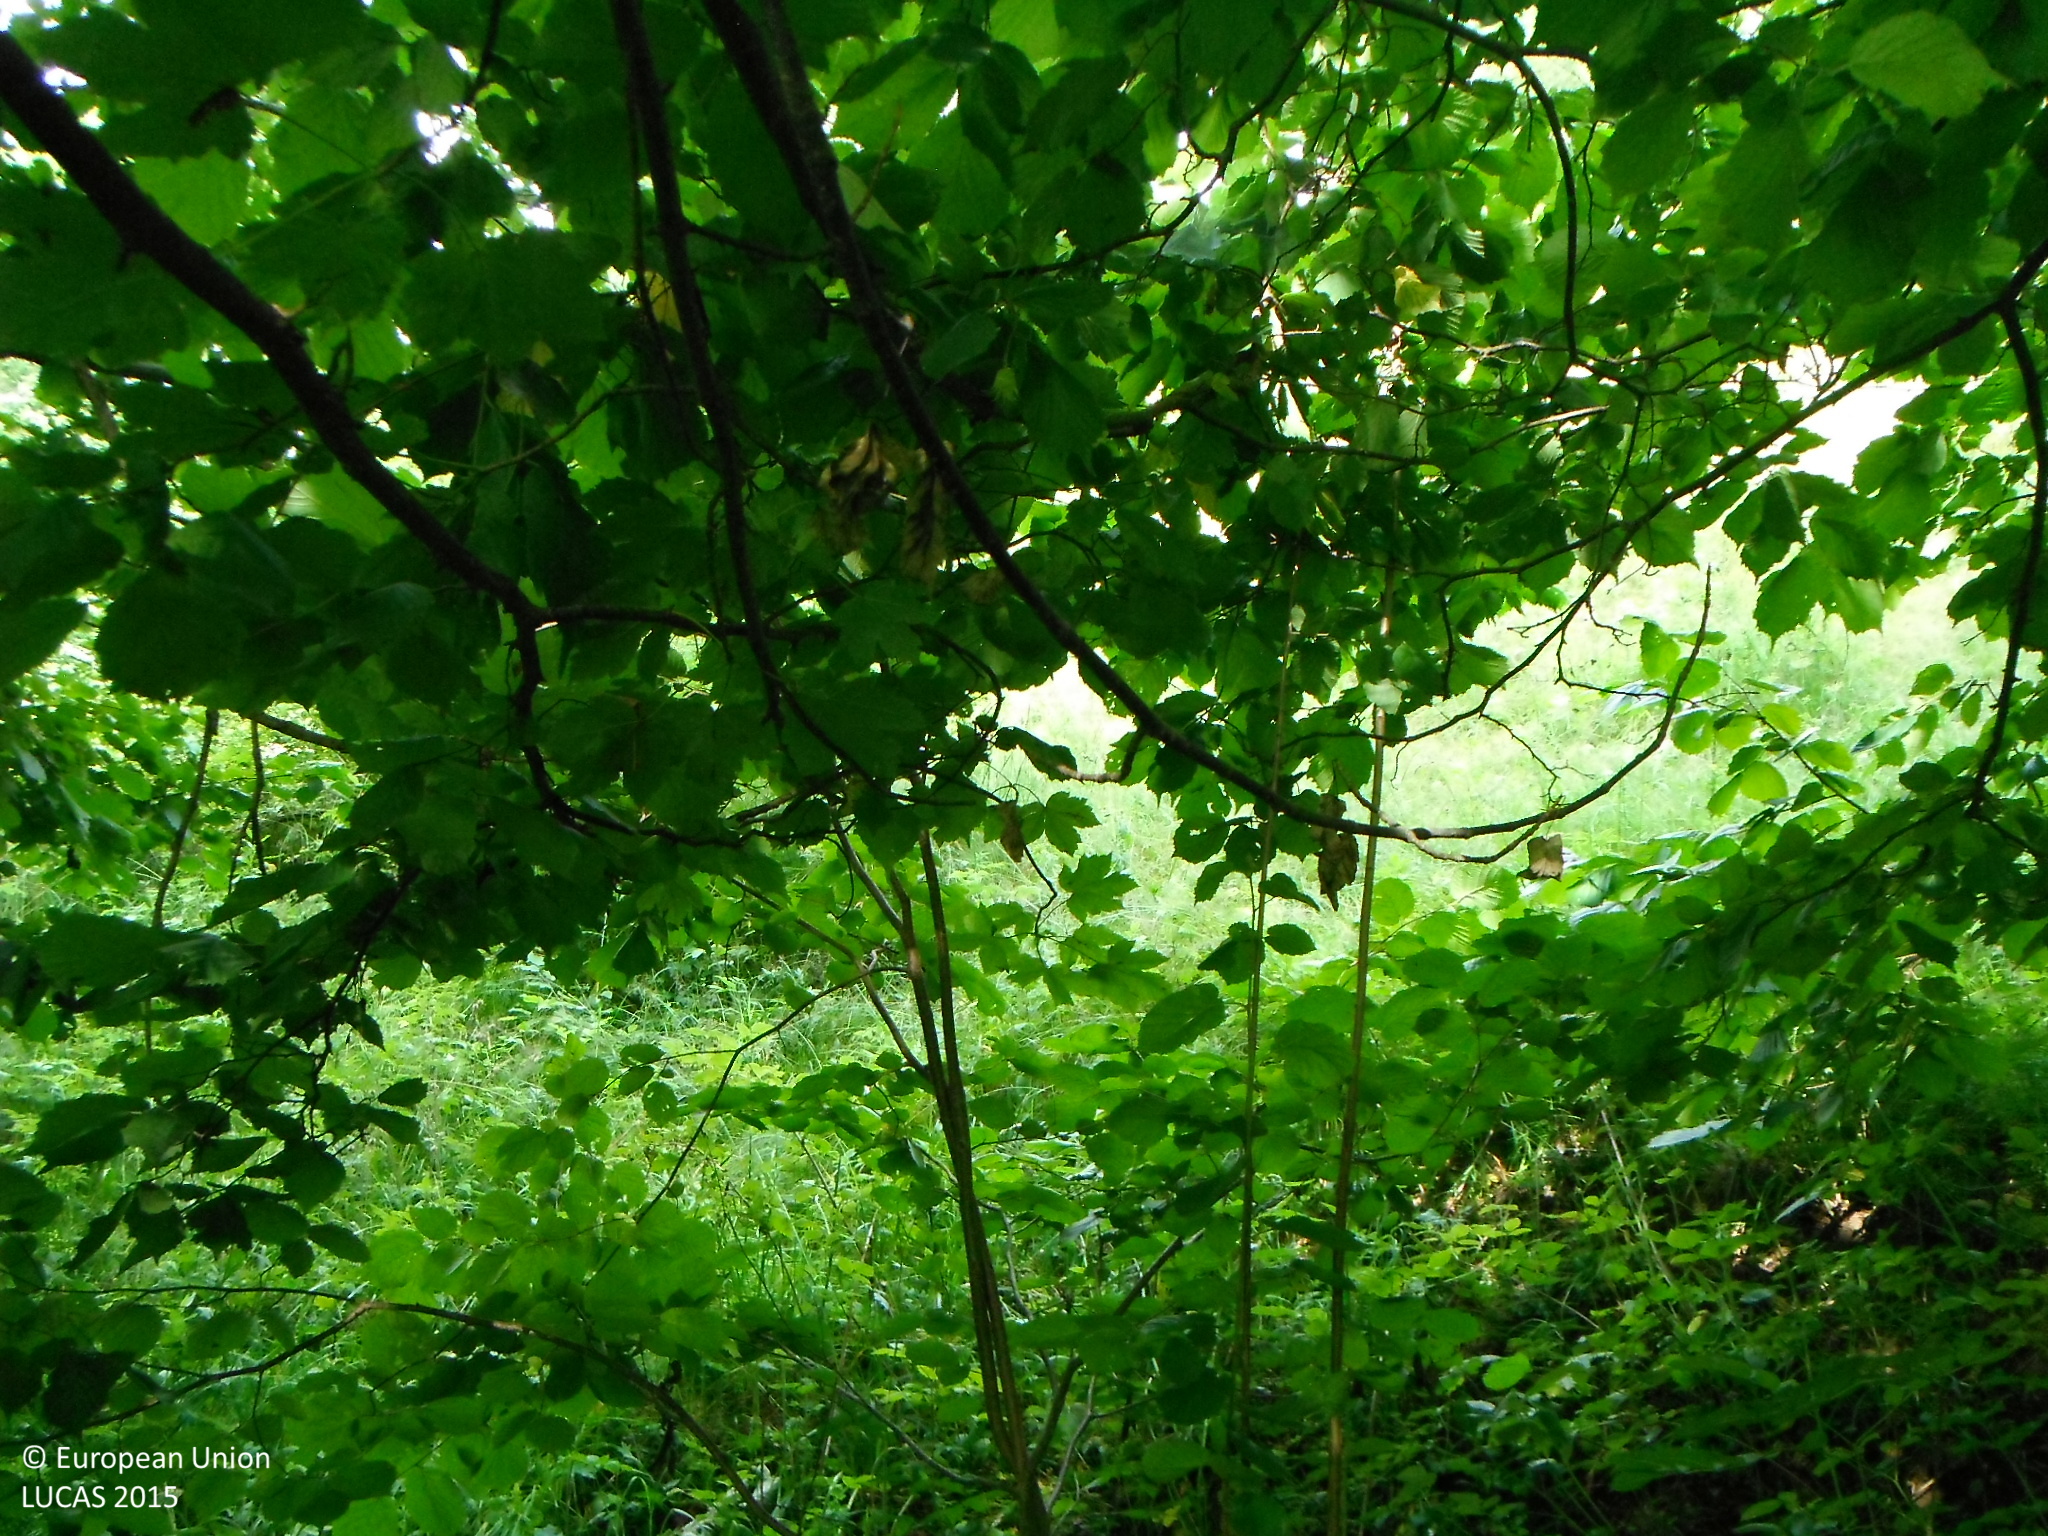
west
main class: Woodland
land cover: Broadleaved woodland
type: mesophytic deciduous forest
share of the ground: > 75 %
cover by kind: broadleaved forest trees 100 %
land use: Semi-natural and natural areas not in use
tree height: > 5 m
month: July
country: SK
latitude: 49.2939
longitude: 19.1118
